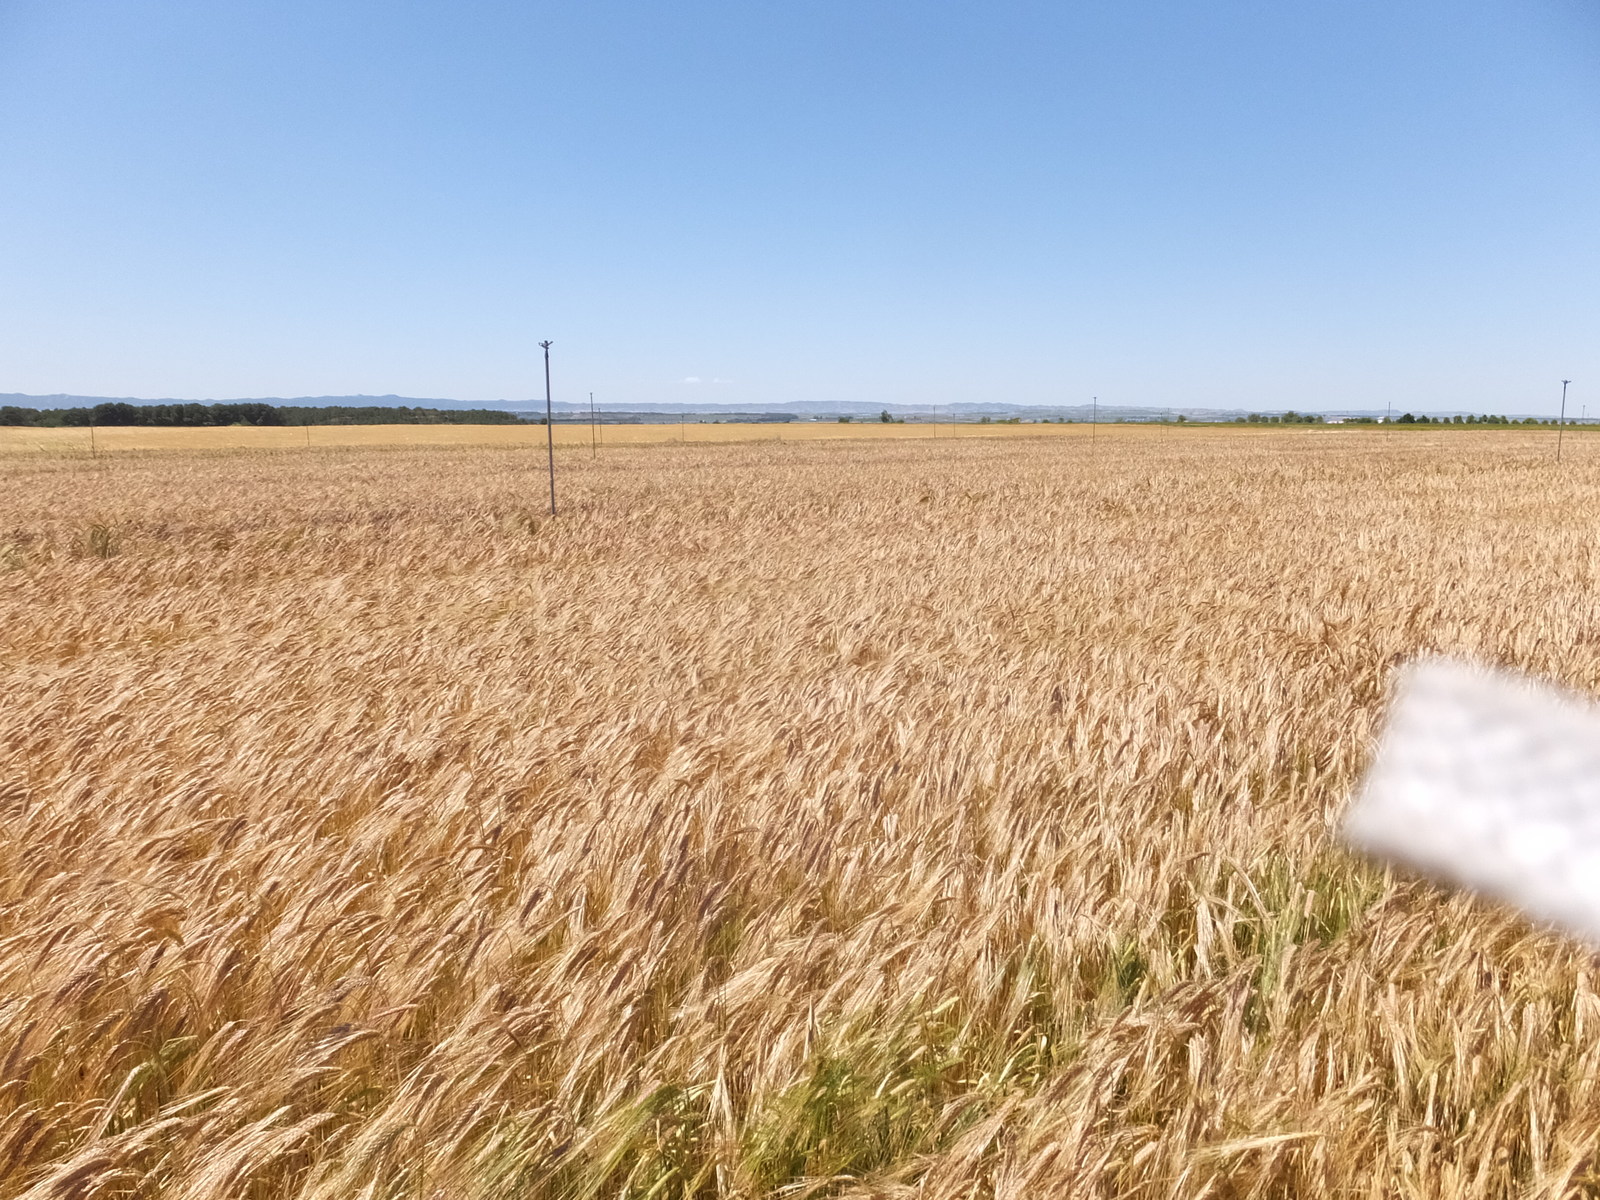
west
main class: Cropland
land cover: Barley
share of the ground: > 75 %
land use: Agriculture (excluding fallow land and kitchen gardens)
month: May
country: ES
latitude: 41.8293
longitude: -0.1929
